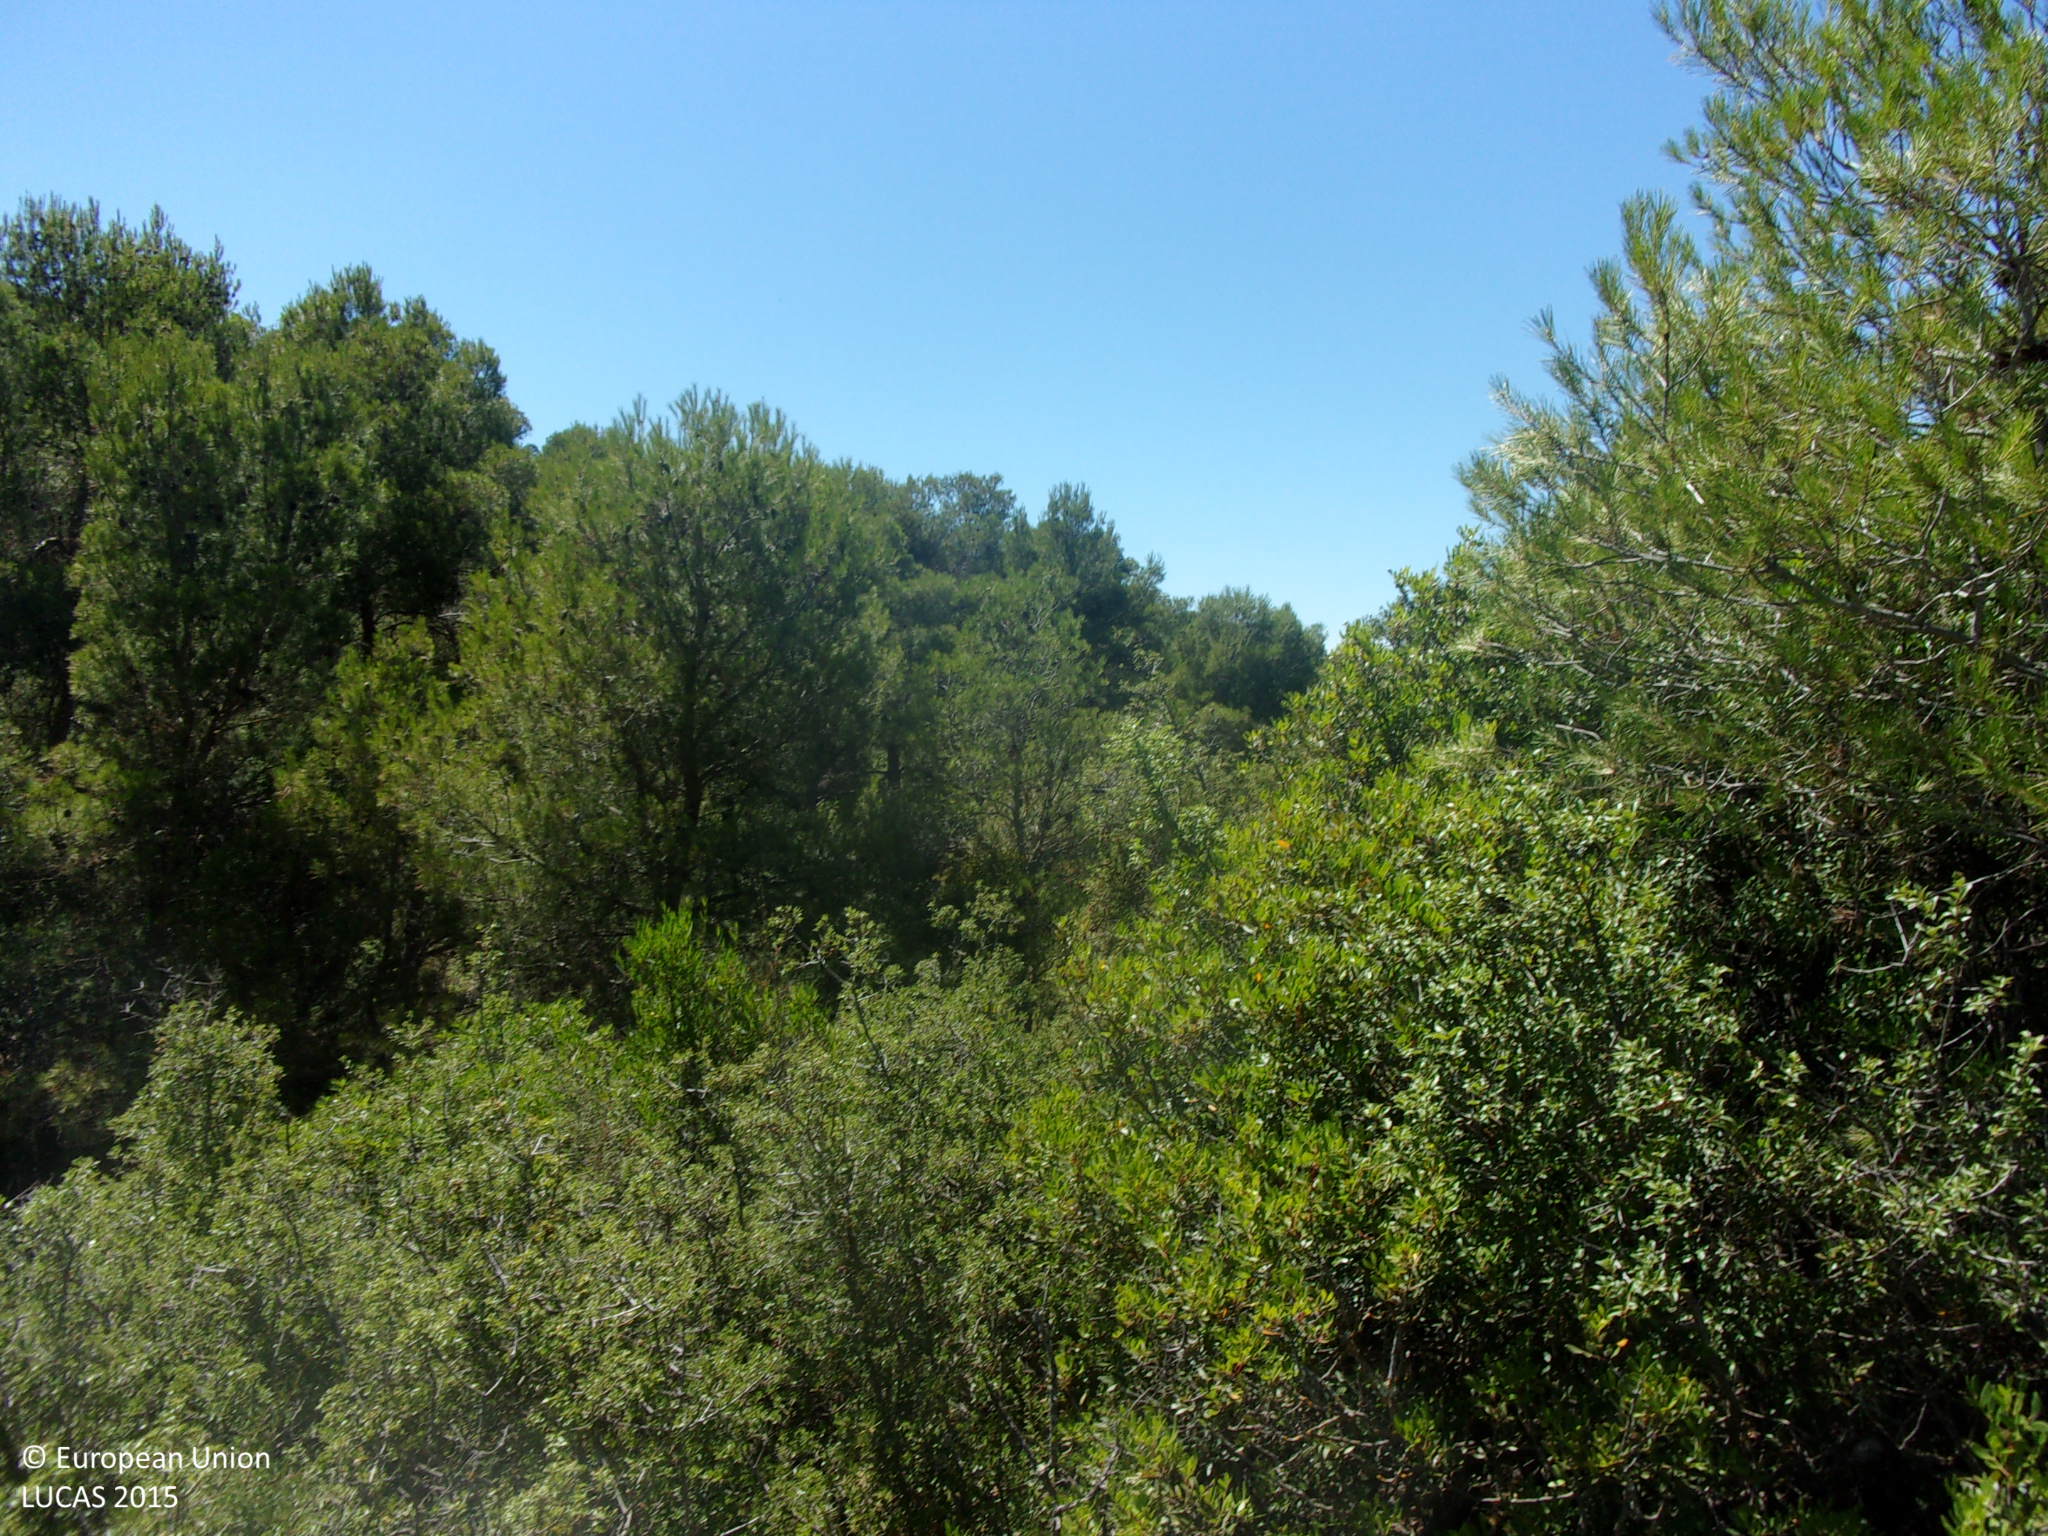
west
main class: Woodland
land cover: Pine dominated coniferous woodland
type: coniferous forest of the mediterranean region
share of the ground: 25 - 50 %
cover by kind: shrubs 70 %, coniferous forest trees 30 %
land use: Forestry
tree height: < 5 m
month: July
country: ES
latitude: 42.0494
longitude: -1.0334
